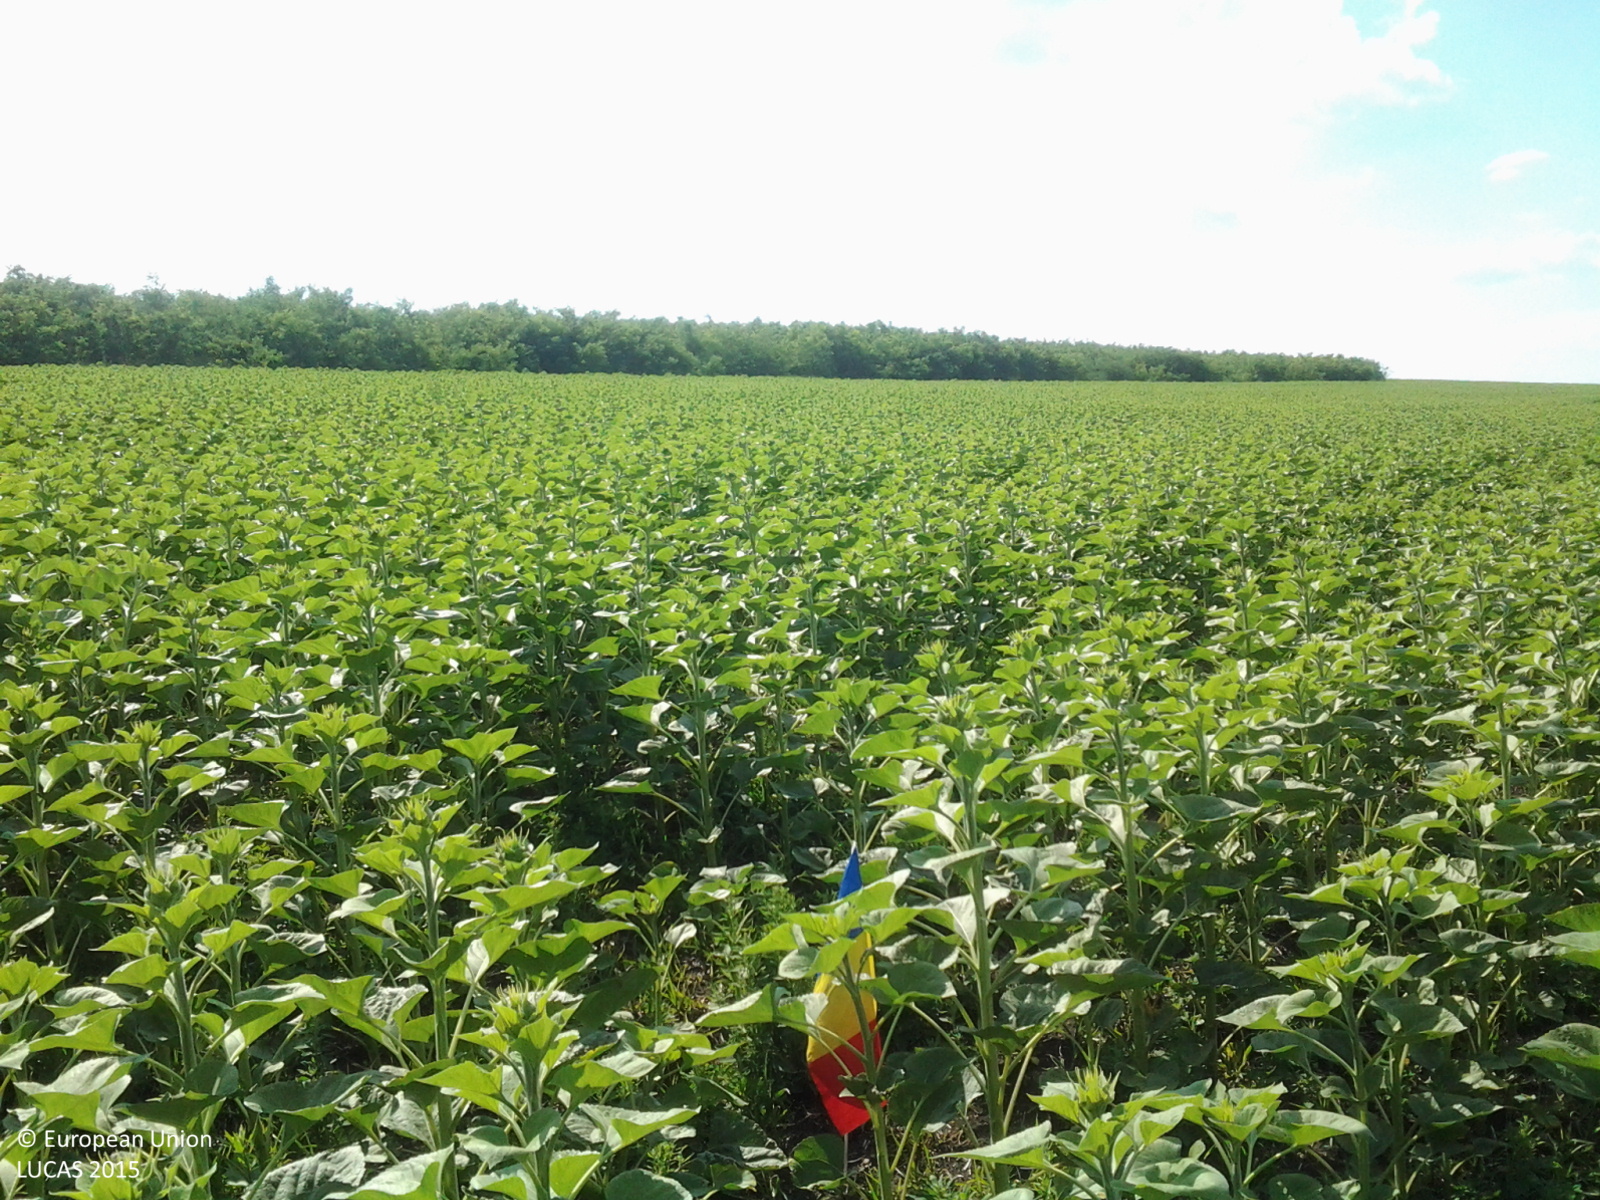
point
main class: Cropland
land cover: Sunflower
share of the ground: 50 - 75 %
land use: Agriculture (excluding fallow land and kitchen gardens)
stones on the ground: < 10 %
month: June
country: RO
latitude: 47.5233
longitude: 27.0651
